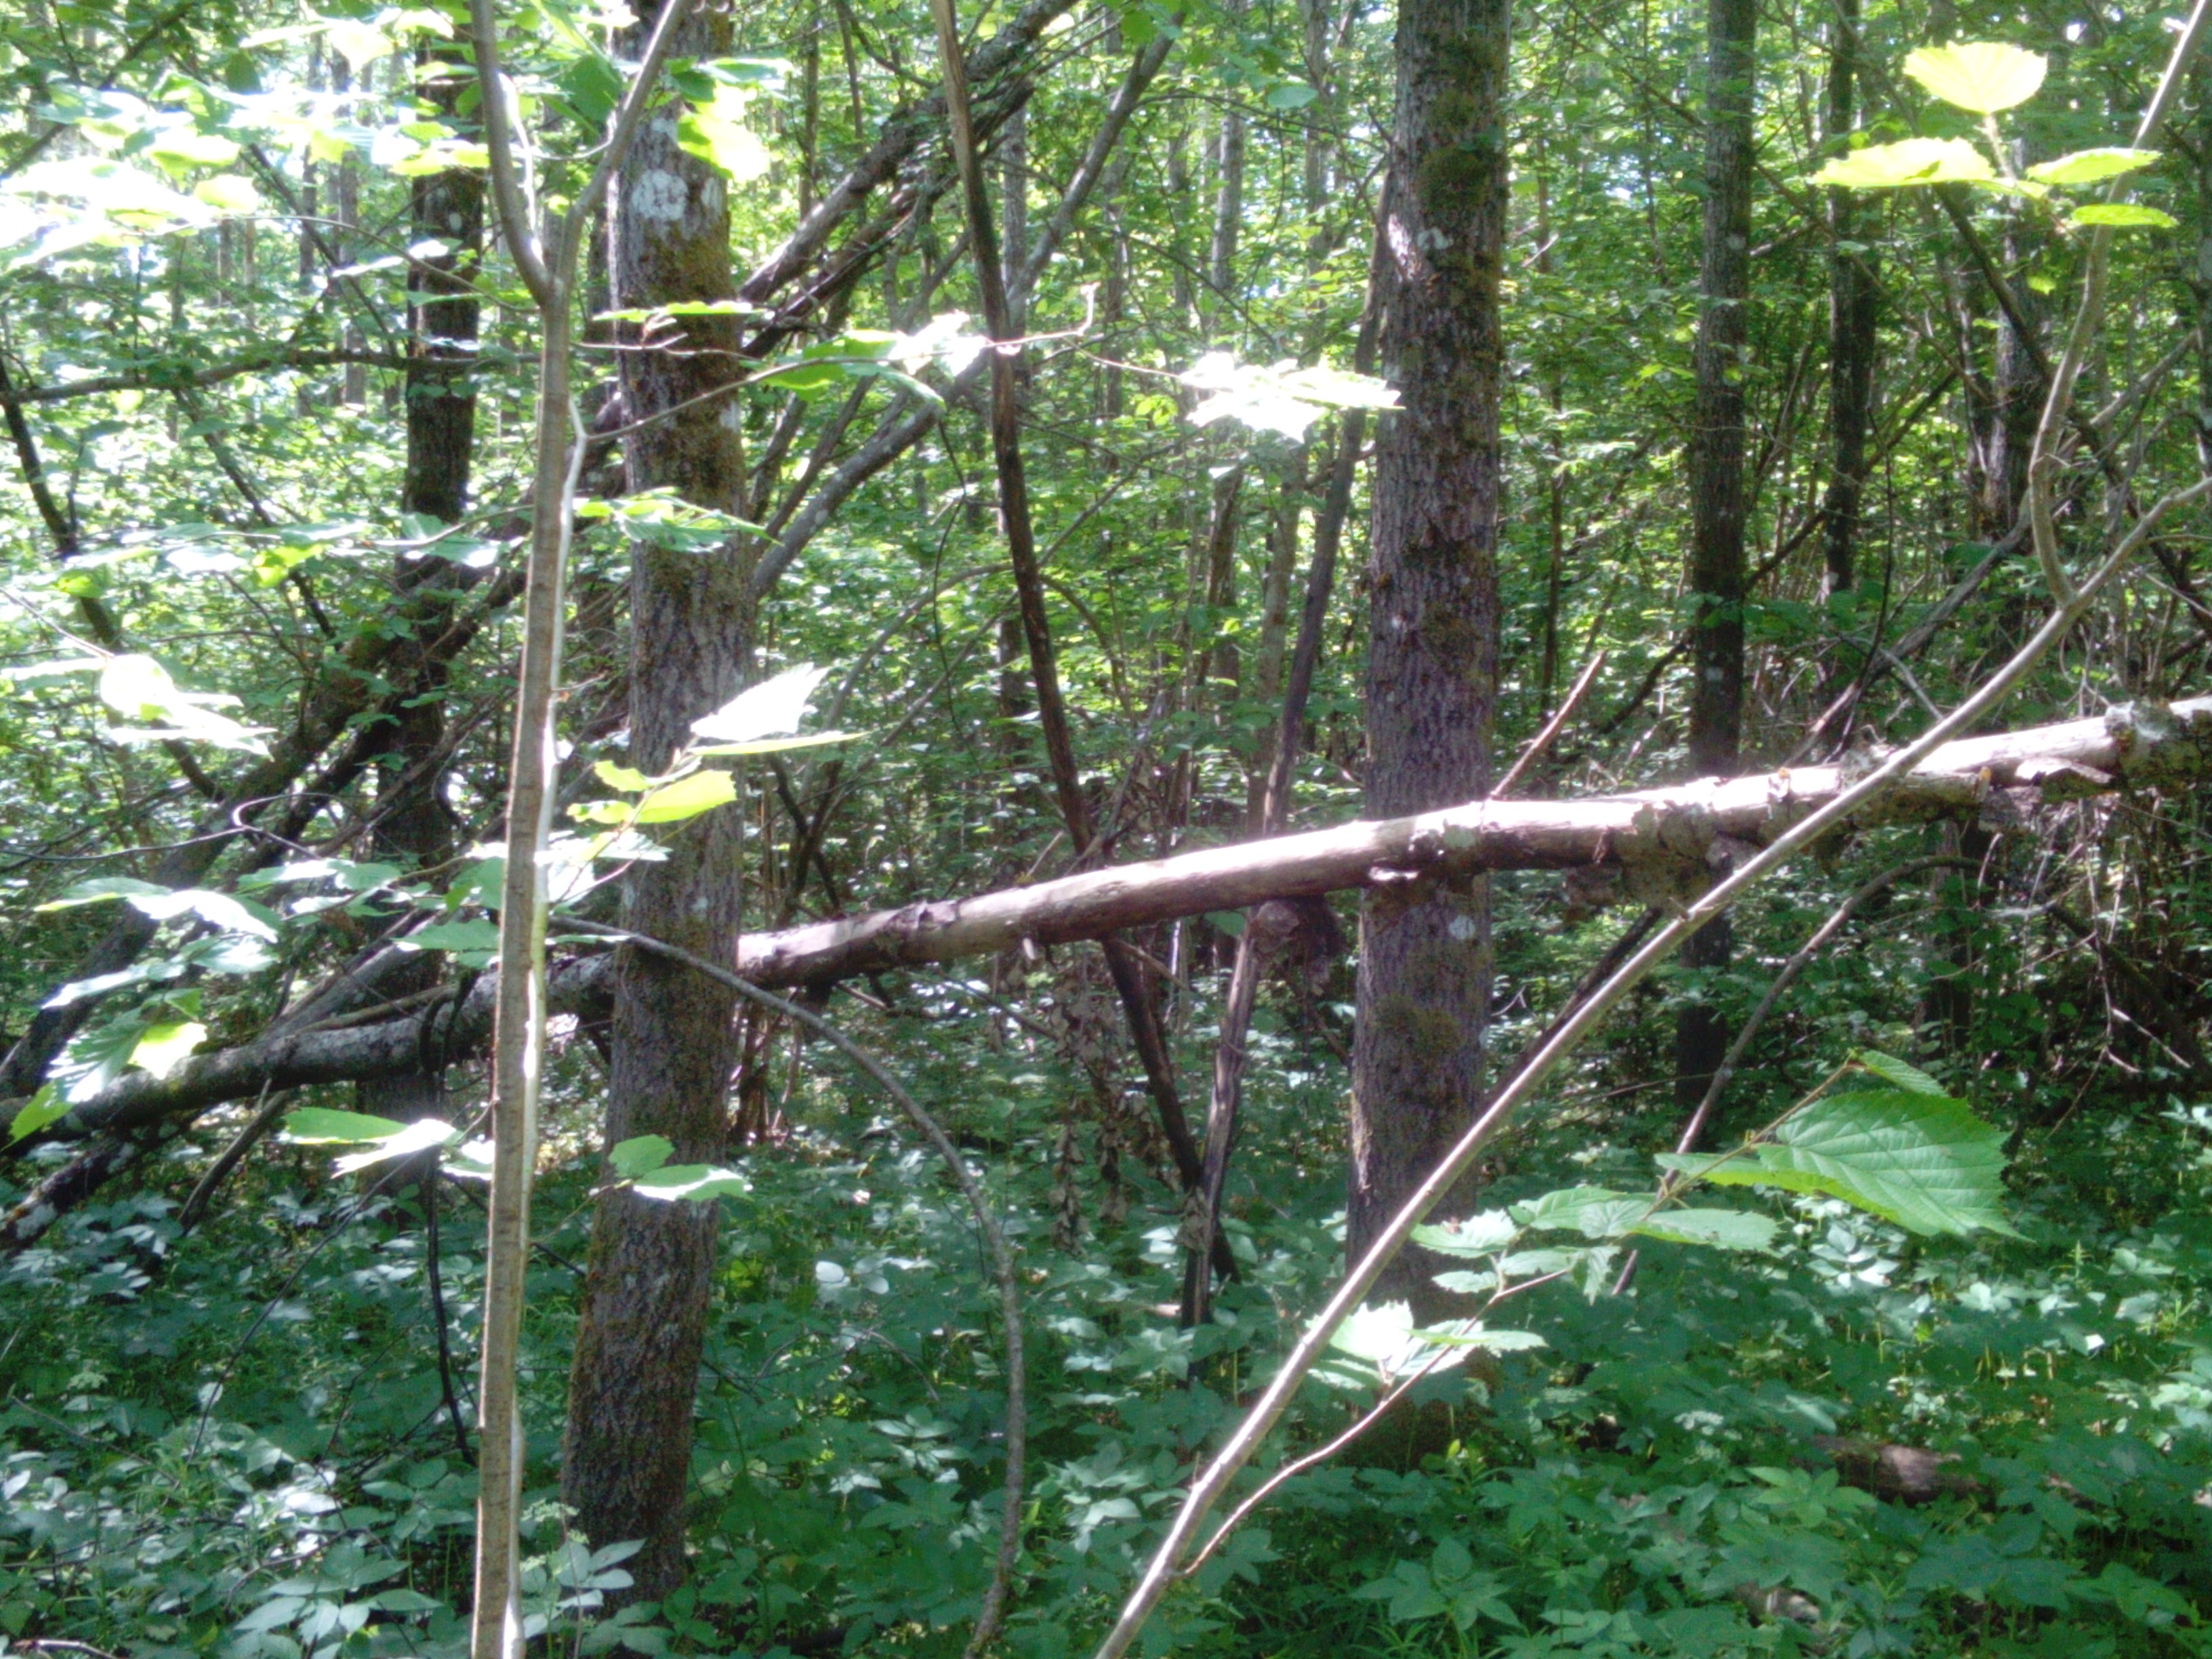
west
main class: Woodland
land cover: Broadleaved woodland
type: non-riverine alder, birch or aspen forest
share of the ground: > 75 %
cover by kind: broadleaved forest trees 90 %, shrubs 5 %, herbaceous plants 5 %
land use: Forestry
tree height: > 5 m
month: June
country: LV
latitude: 56.8126
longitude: 21.7233
